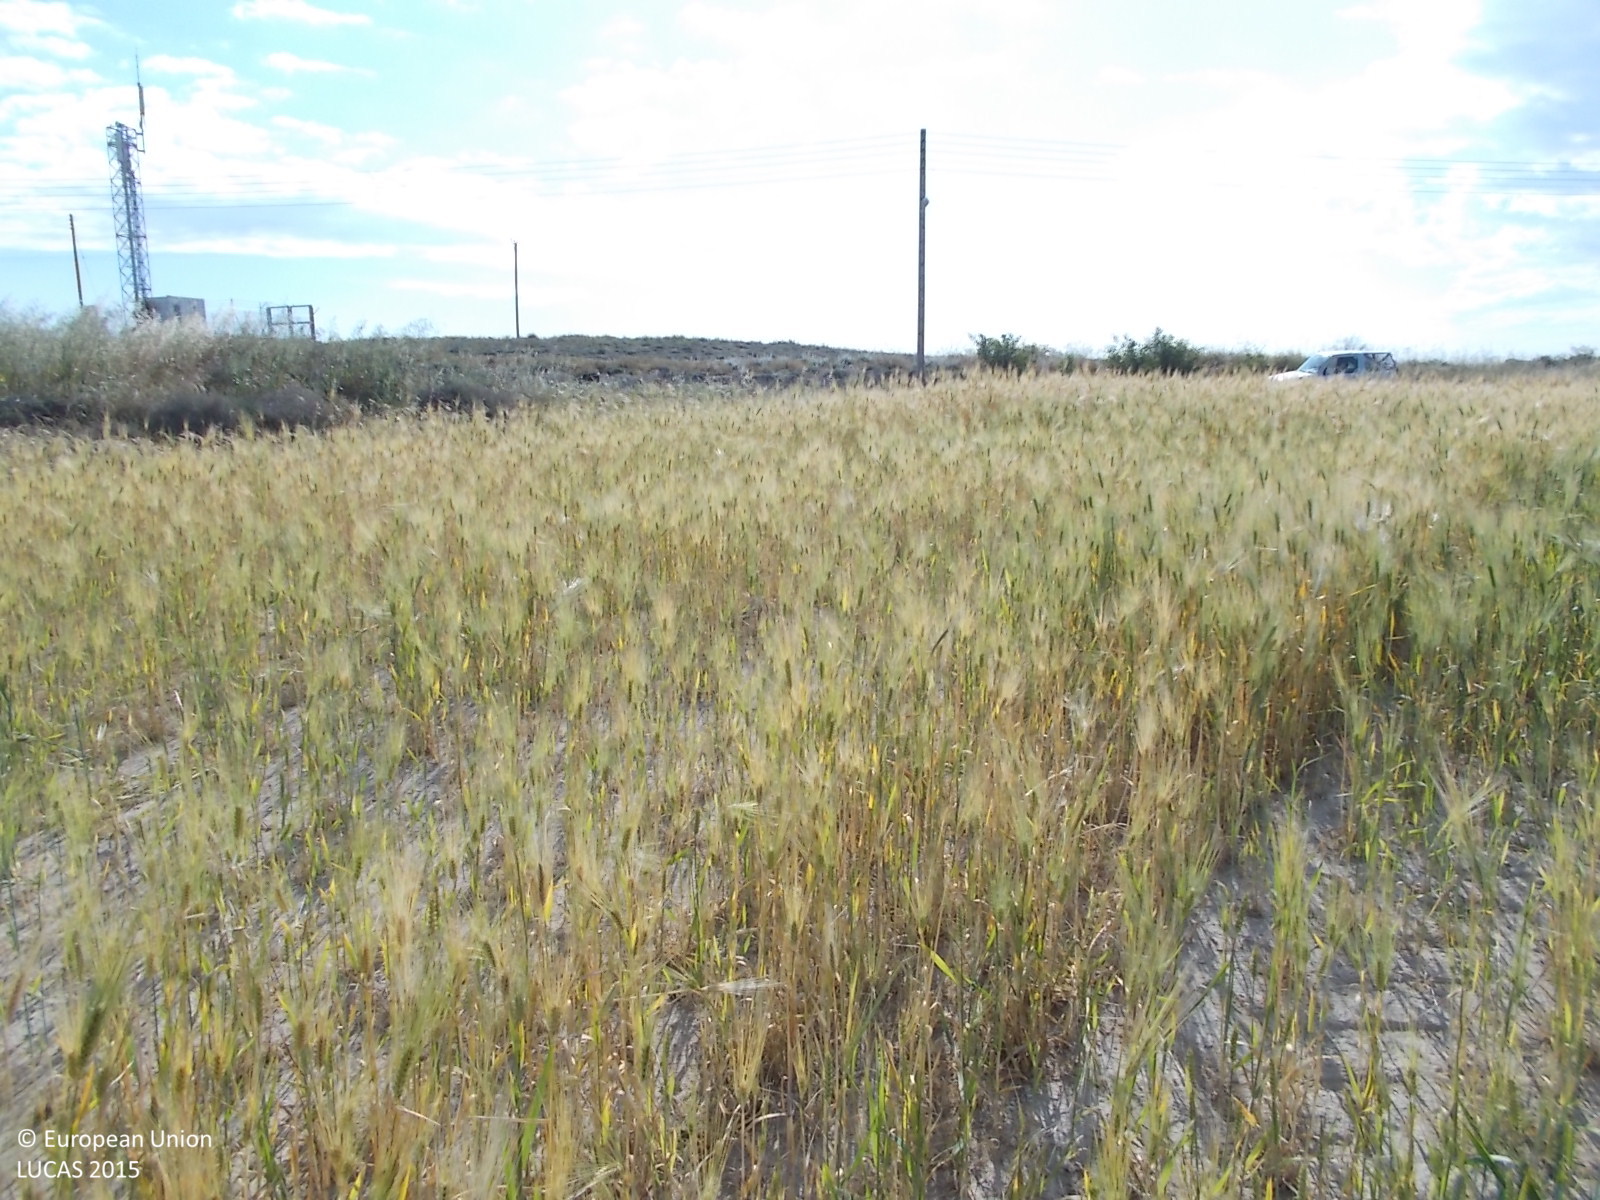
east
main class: Cropland
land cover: Barley
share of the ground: > 75 %
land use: Agriculture (excluding fallow land and kitchen gardens)
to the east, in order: Barley; Grass margins; Shrubland without tree cover; Grass margins; Paved roads, cycling and walking lanes; Electric lines; Shrubland without tree cover; Tracks; Spontaneously vegetated surfaces; Electric lines; Spontaneously vegetated surfaces; Common wheat; Mixed cereals for fodder
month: April
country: CY
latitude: 34.8259
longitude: 33.6010
